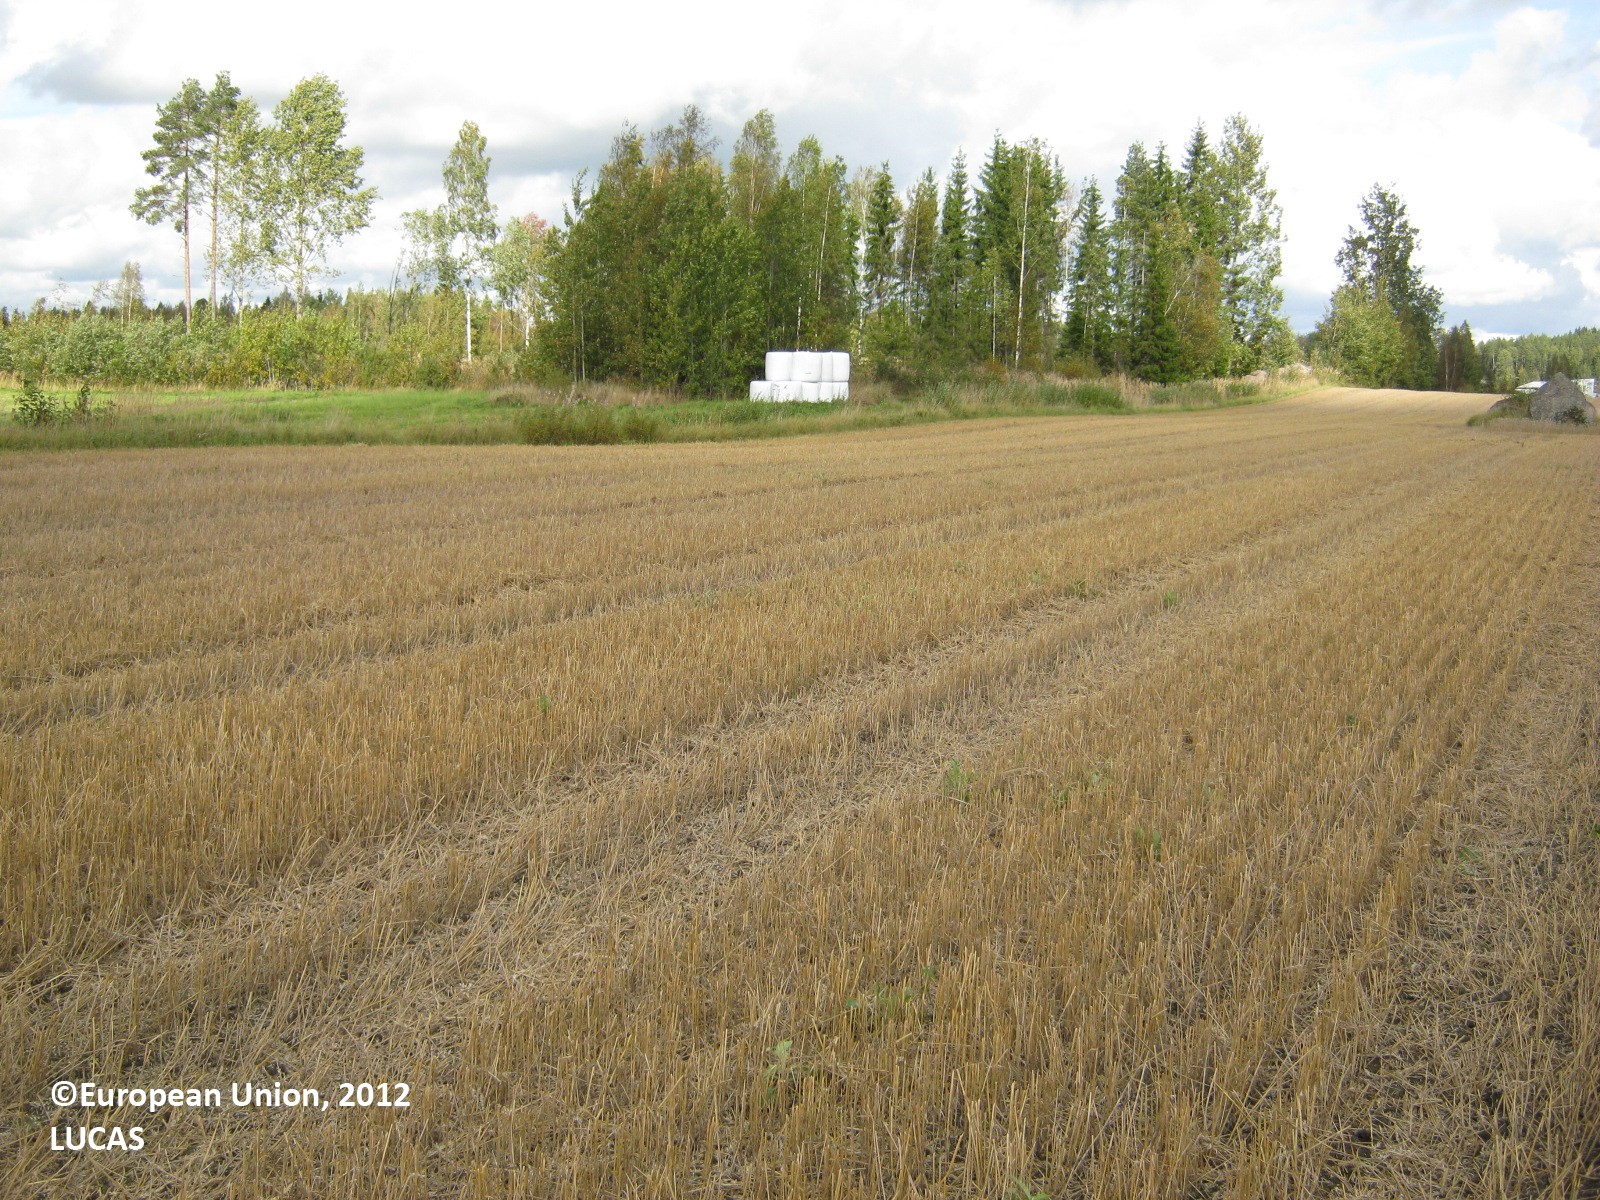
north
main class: Cropland
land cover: Common wheat
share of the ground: > 75 %
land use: Agriculture (excluding fallow land and kitchen gardens)
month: September
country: FI
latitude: 60.6454
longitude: 27.8063
